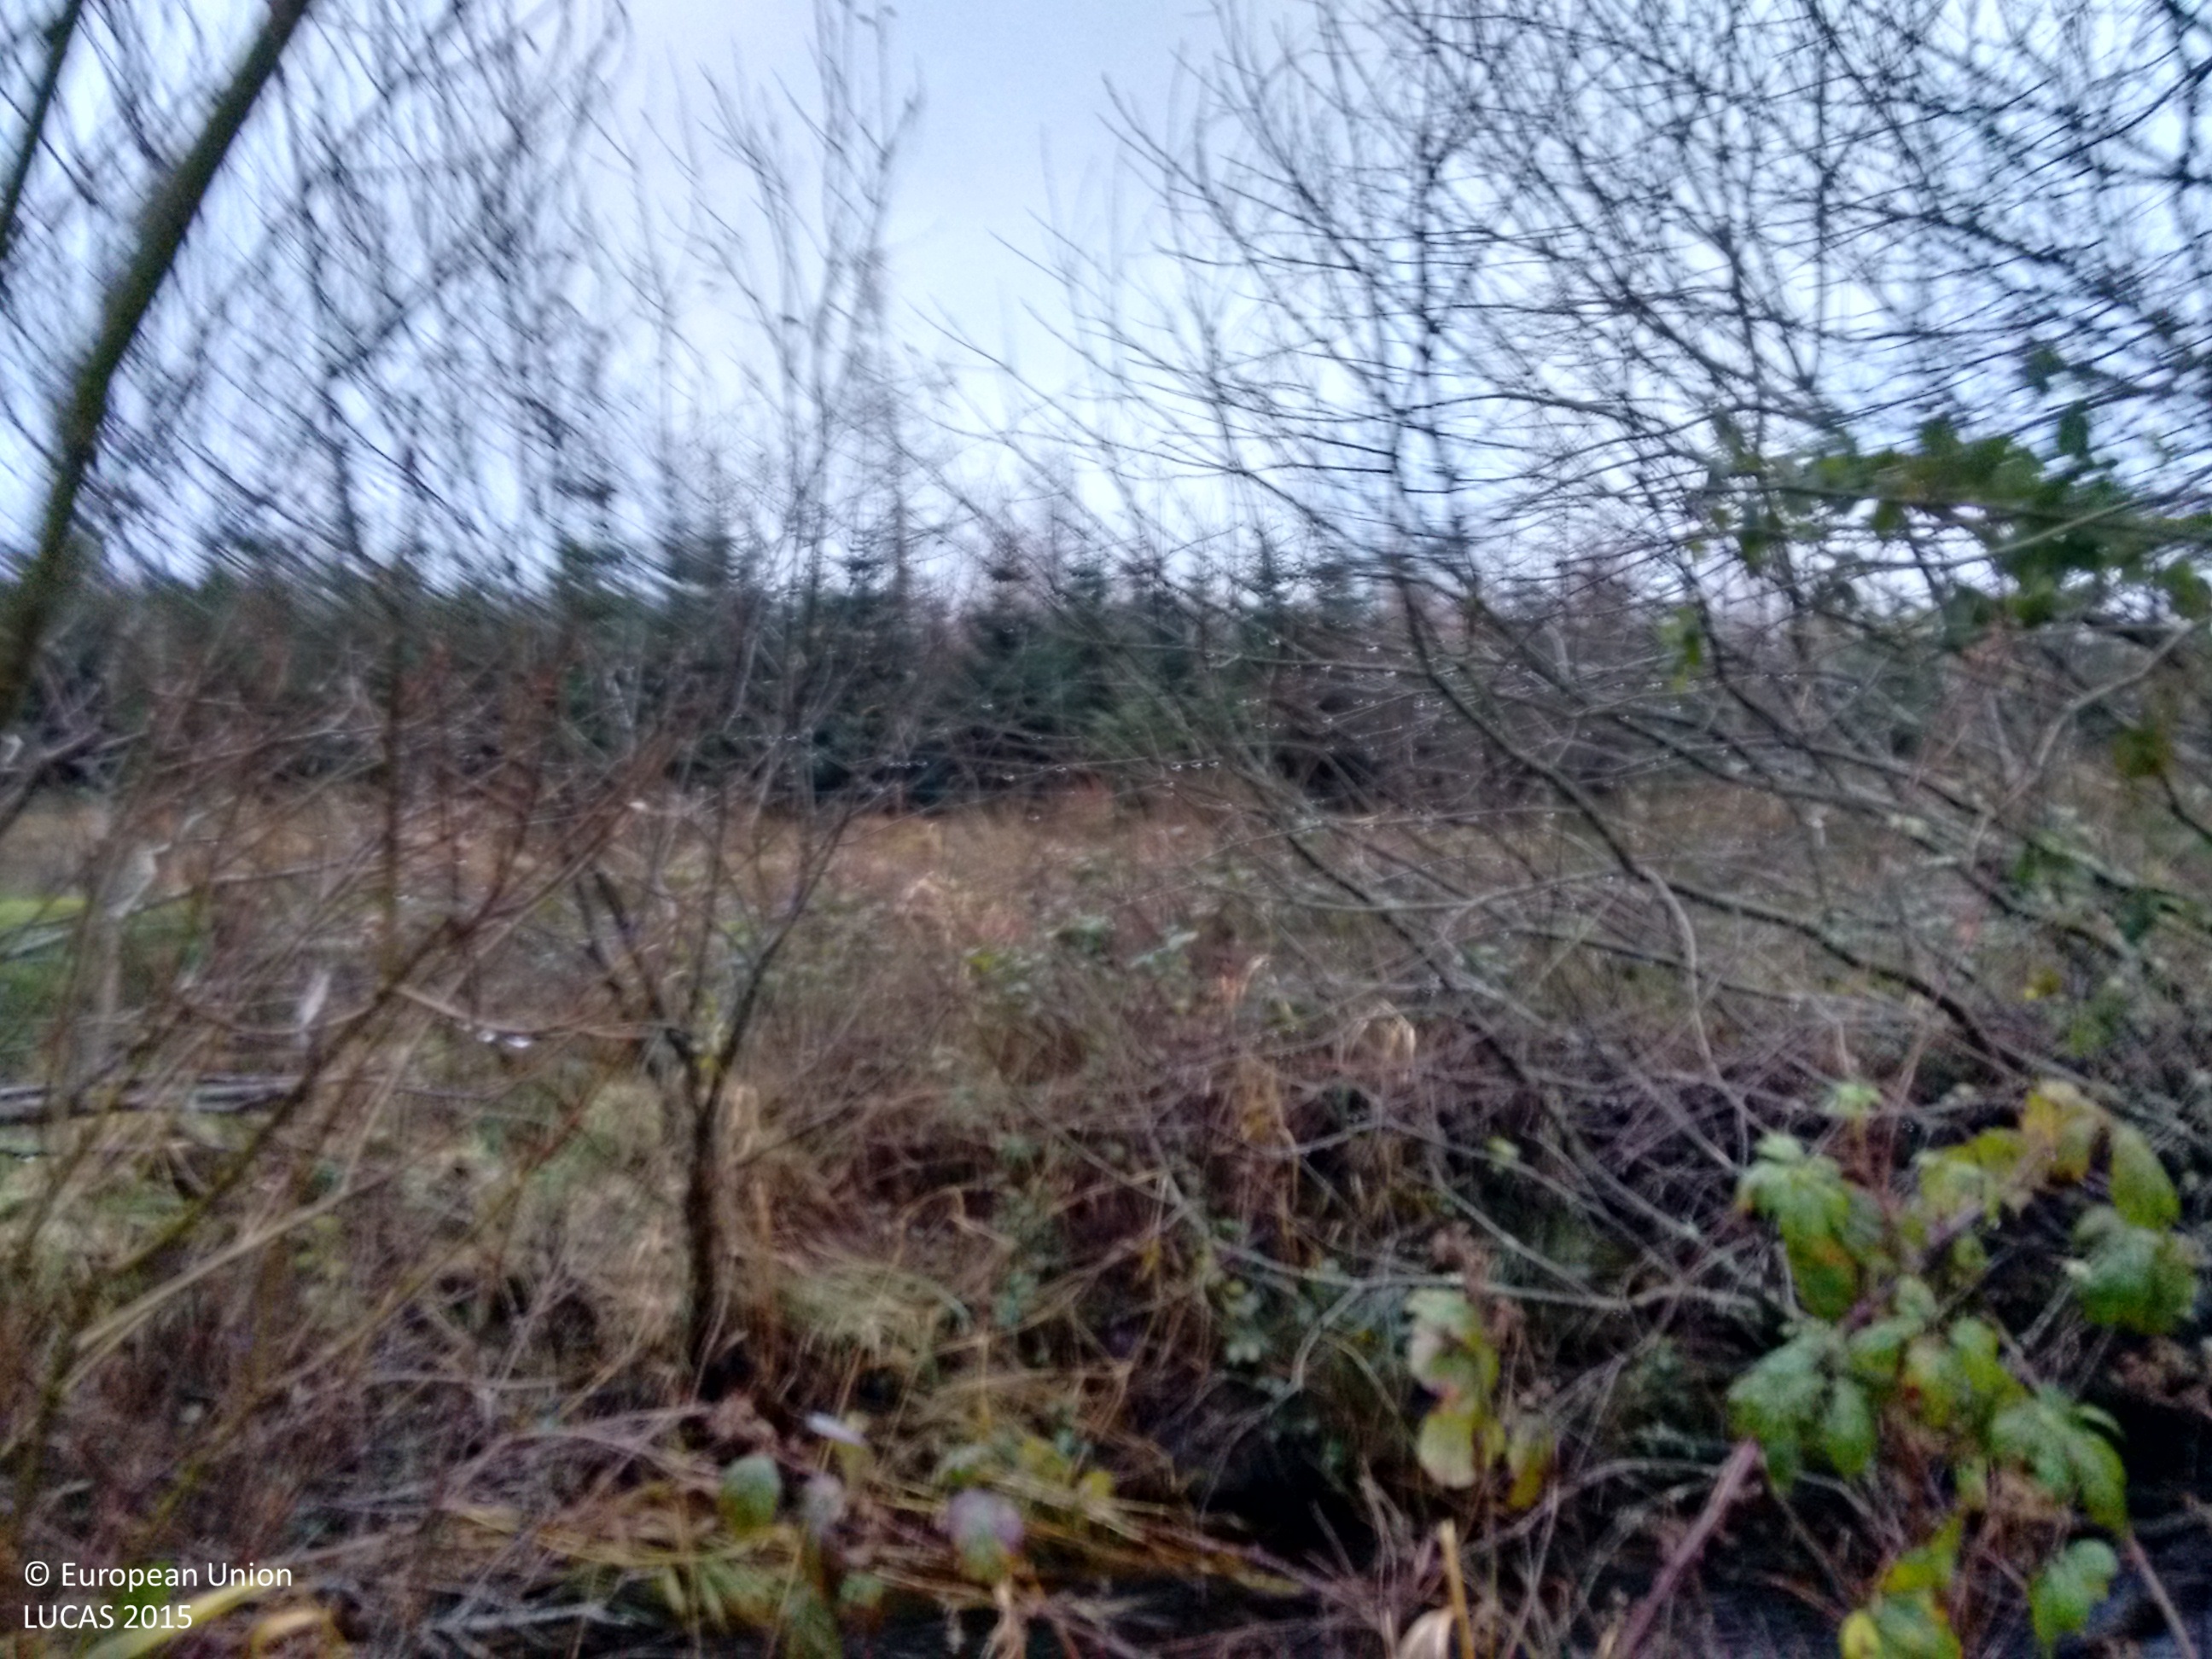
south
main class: Woodland
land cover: Spruce dominated coniferous woodland
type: exotic forest
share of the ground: > 75 %
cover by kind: coniferous forest trees 100 %
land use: Forestry
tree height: > 5 m
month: December
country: IE
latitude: 54.2223
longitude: -7.9480
